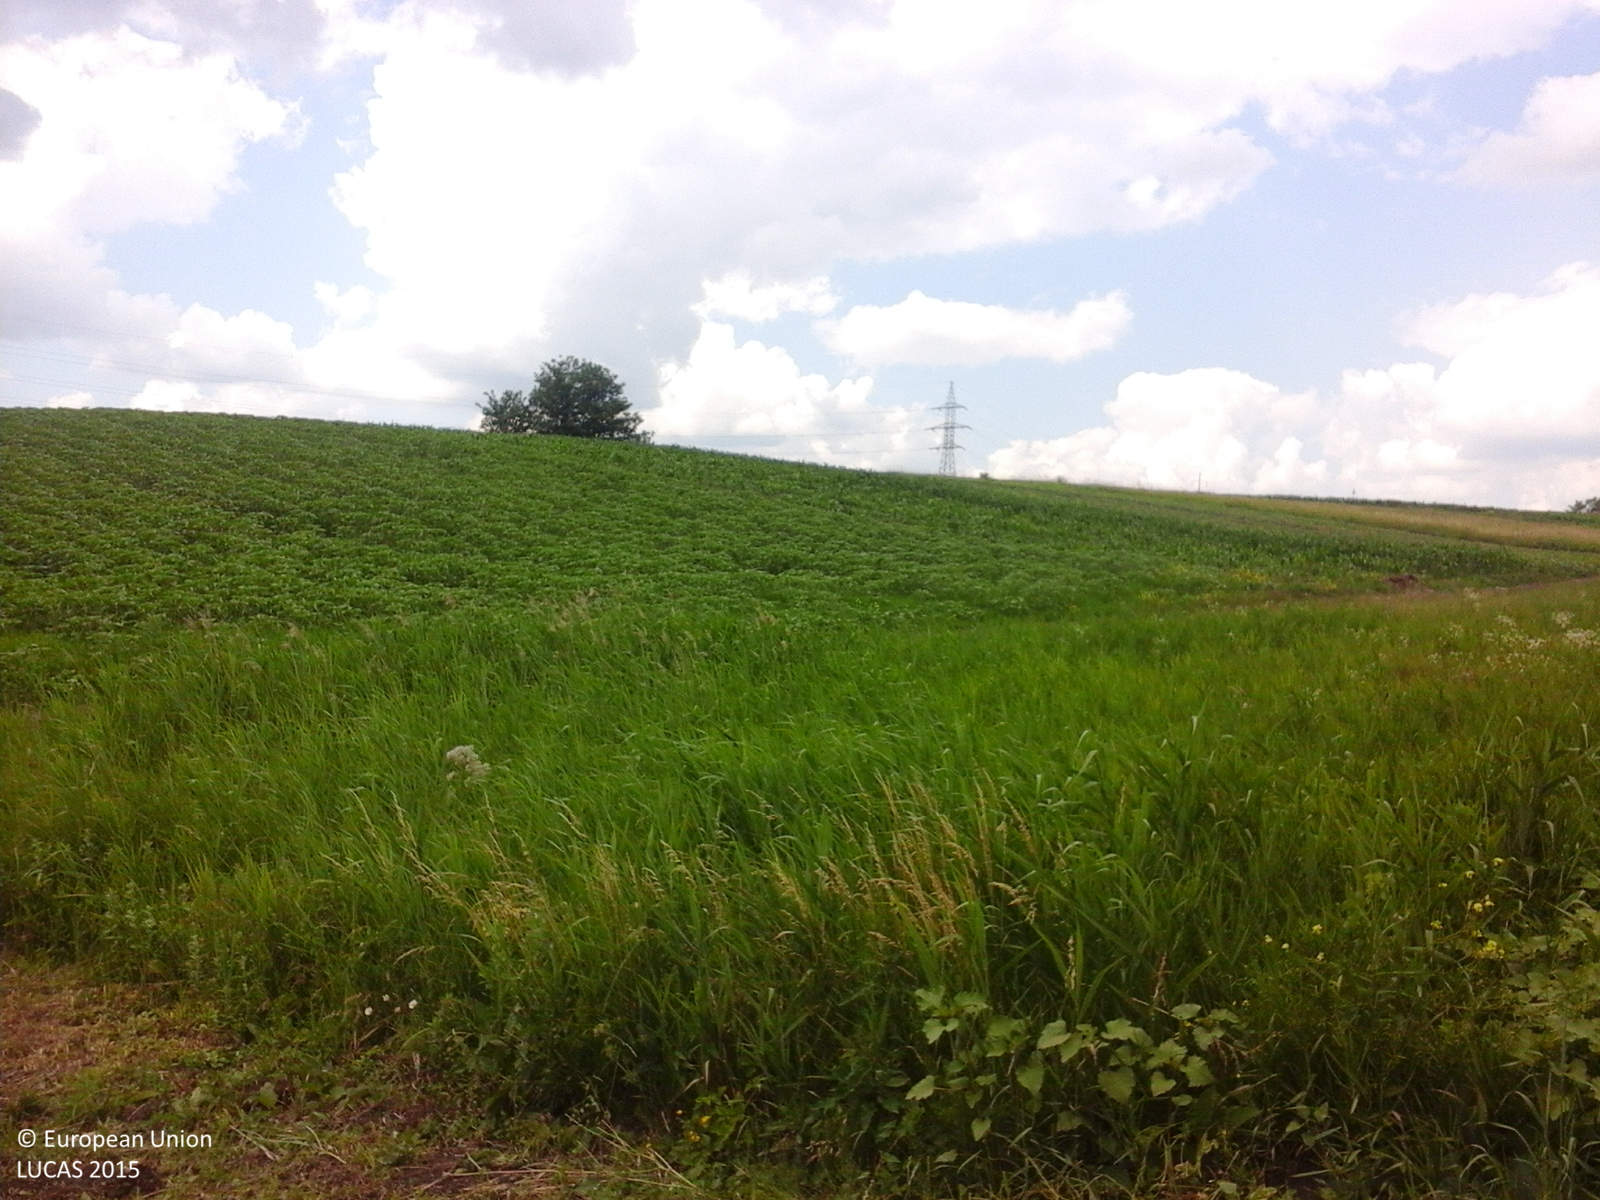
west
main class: Cropland
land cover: Oats
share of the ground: < 10 %
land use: Agriculture (excluding fallow land and kitchen gardens)
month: June
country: RO
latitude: 48.1410
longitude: 26.6404
